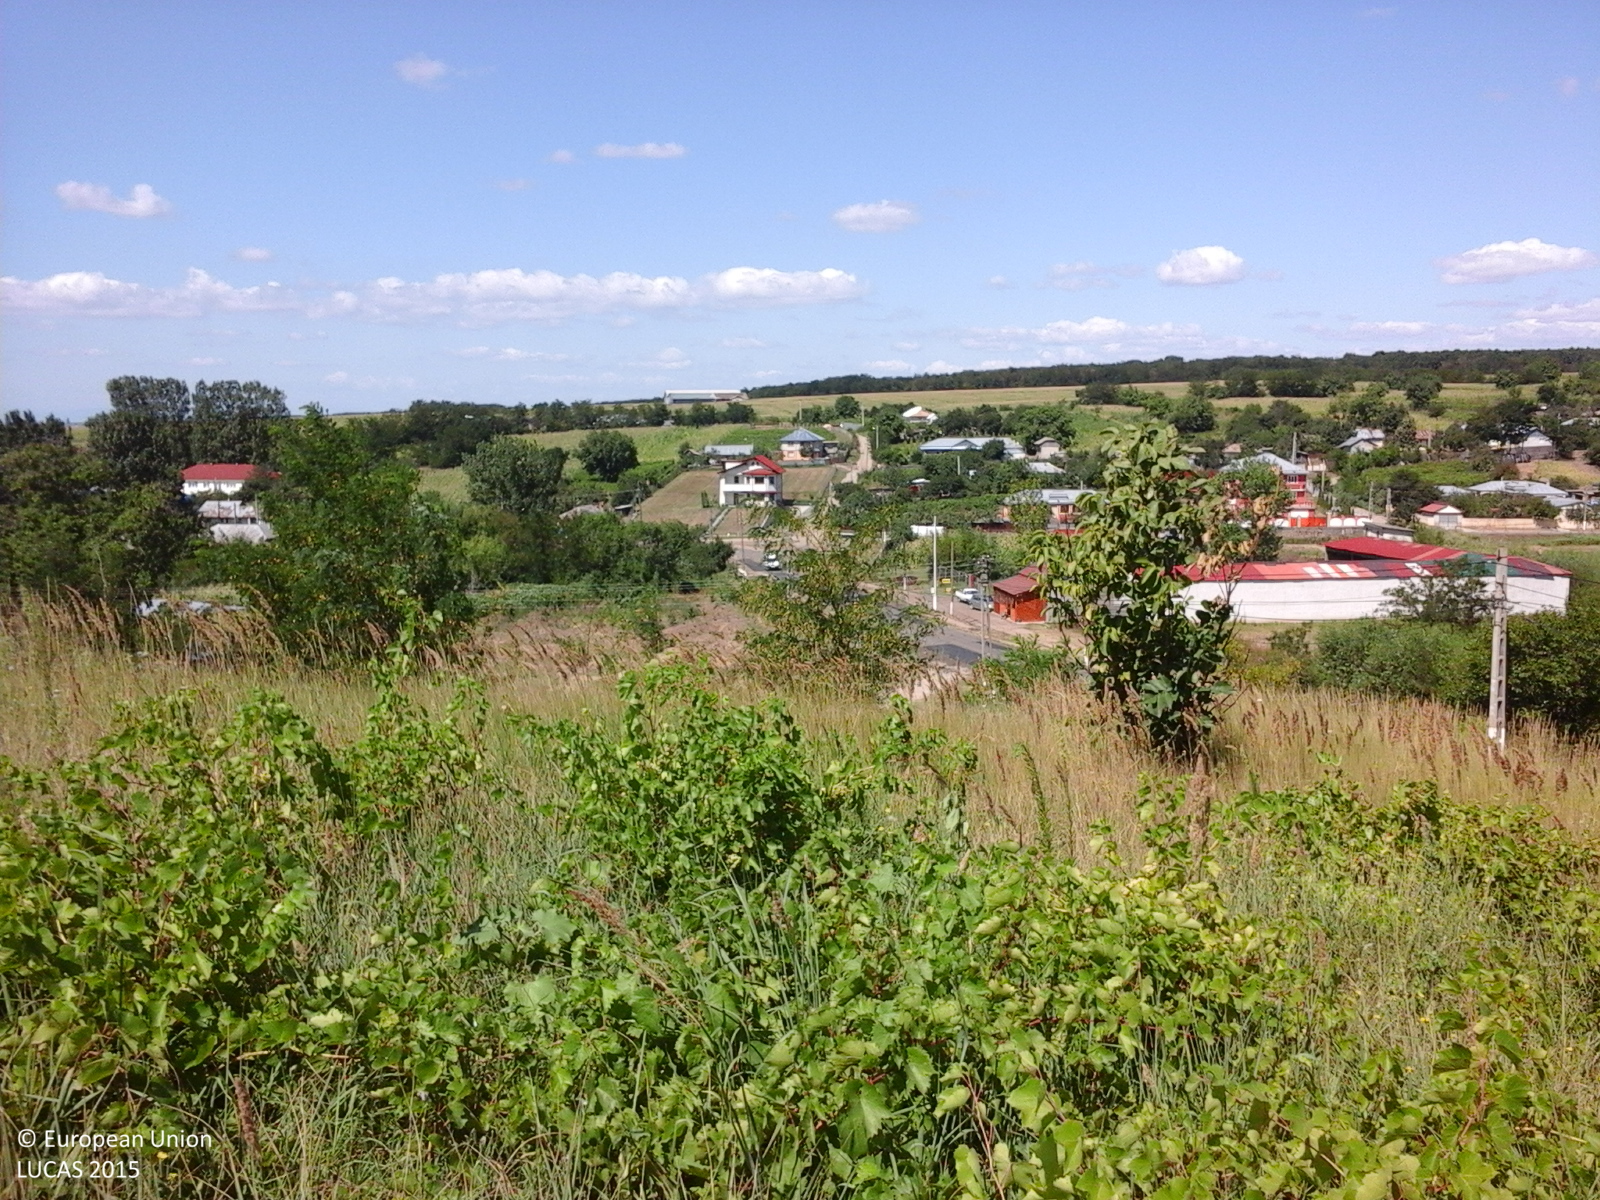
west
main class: Cropland
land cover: Vineyards
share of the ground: > 75 %
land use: Agriculture (excluding fallow land and kitchen gardens)
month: July
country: RO
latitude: 45.9782
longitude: 27.7321
